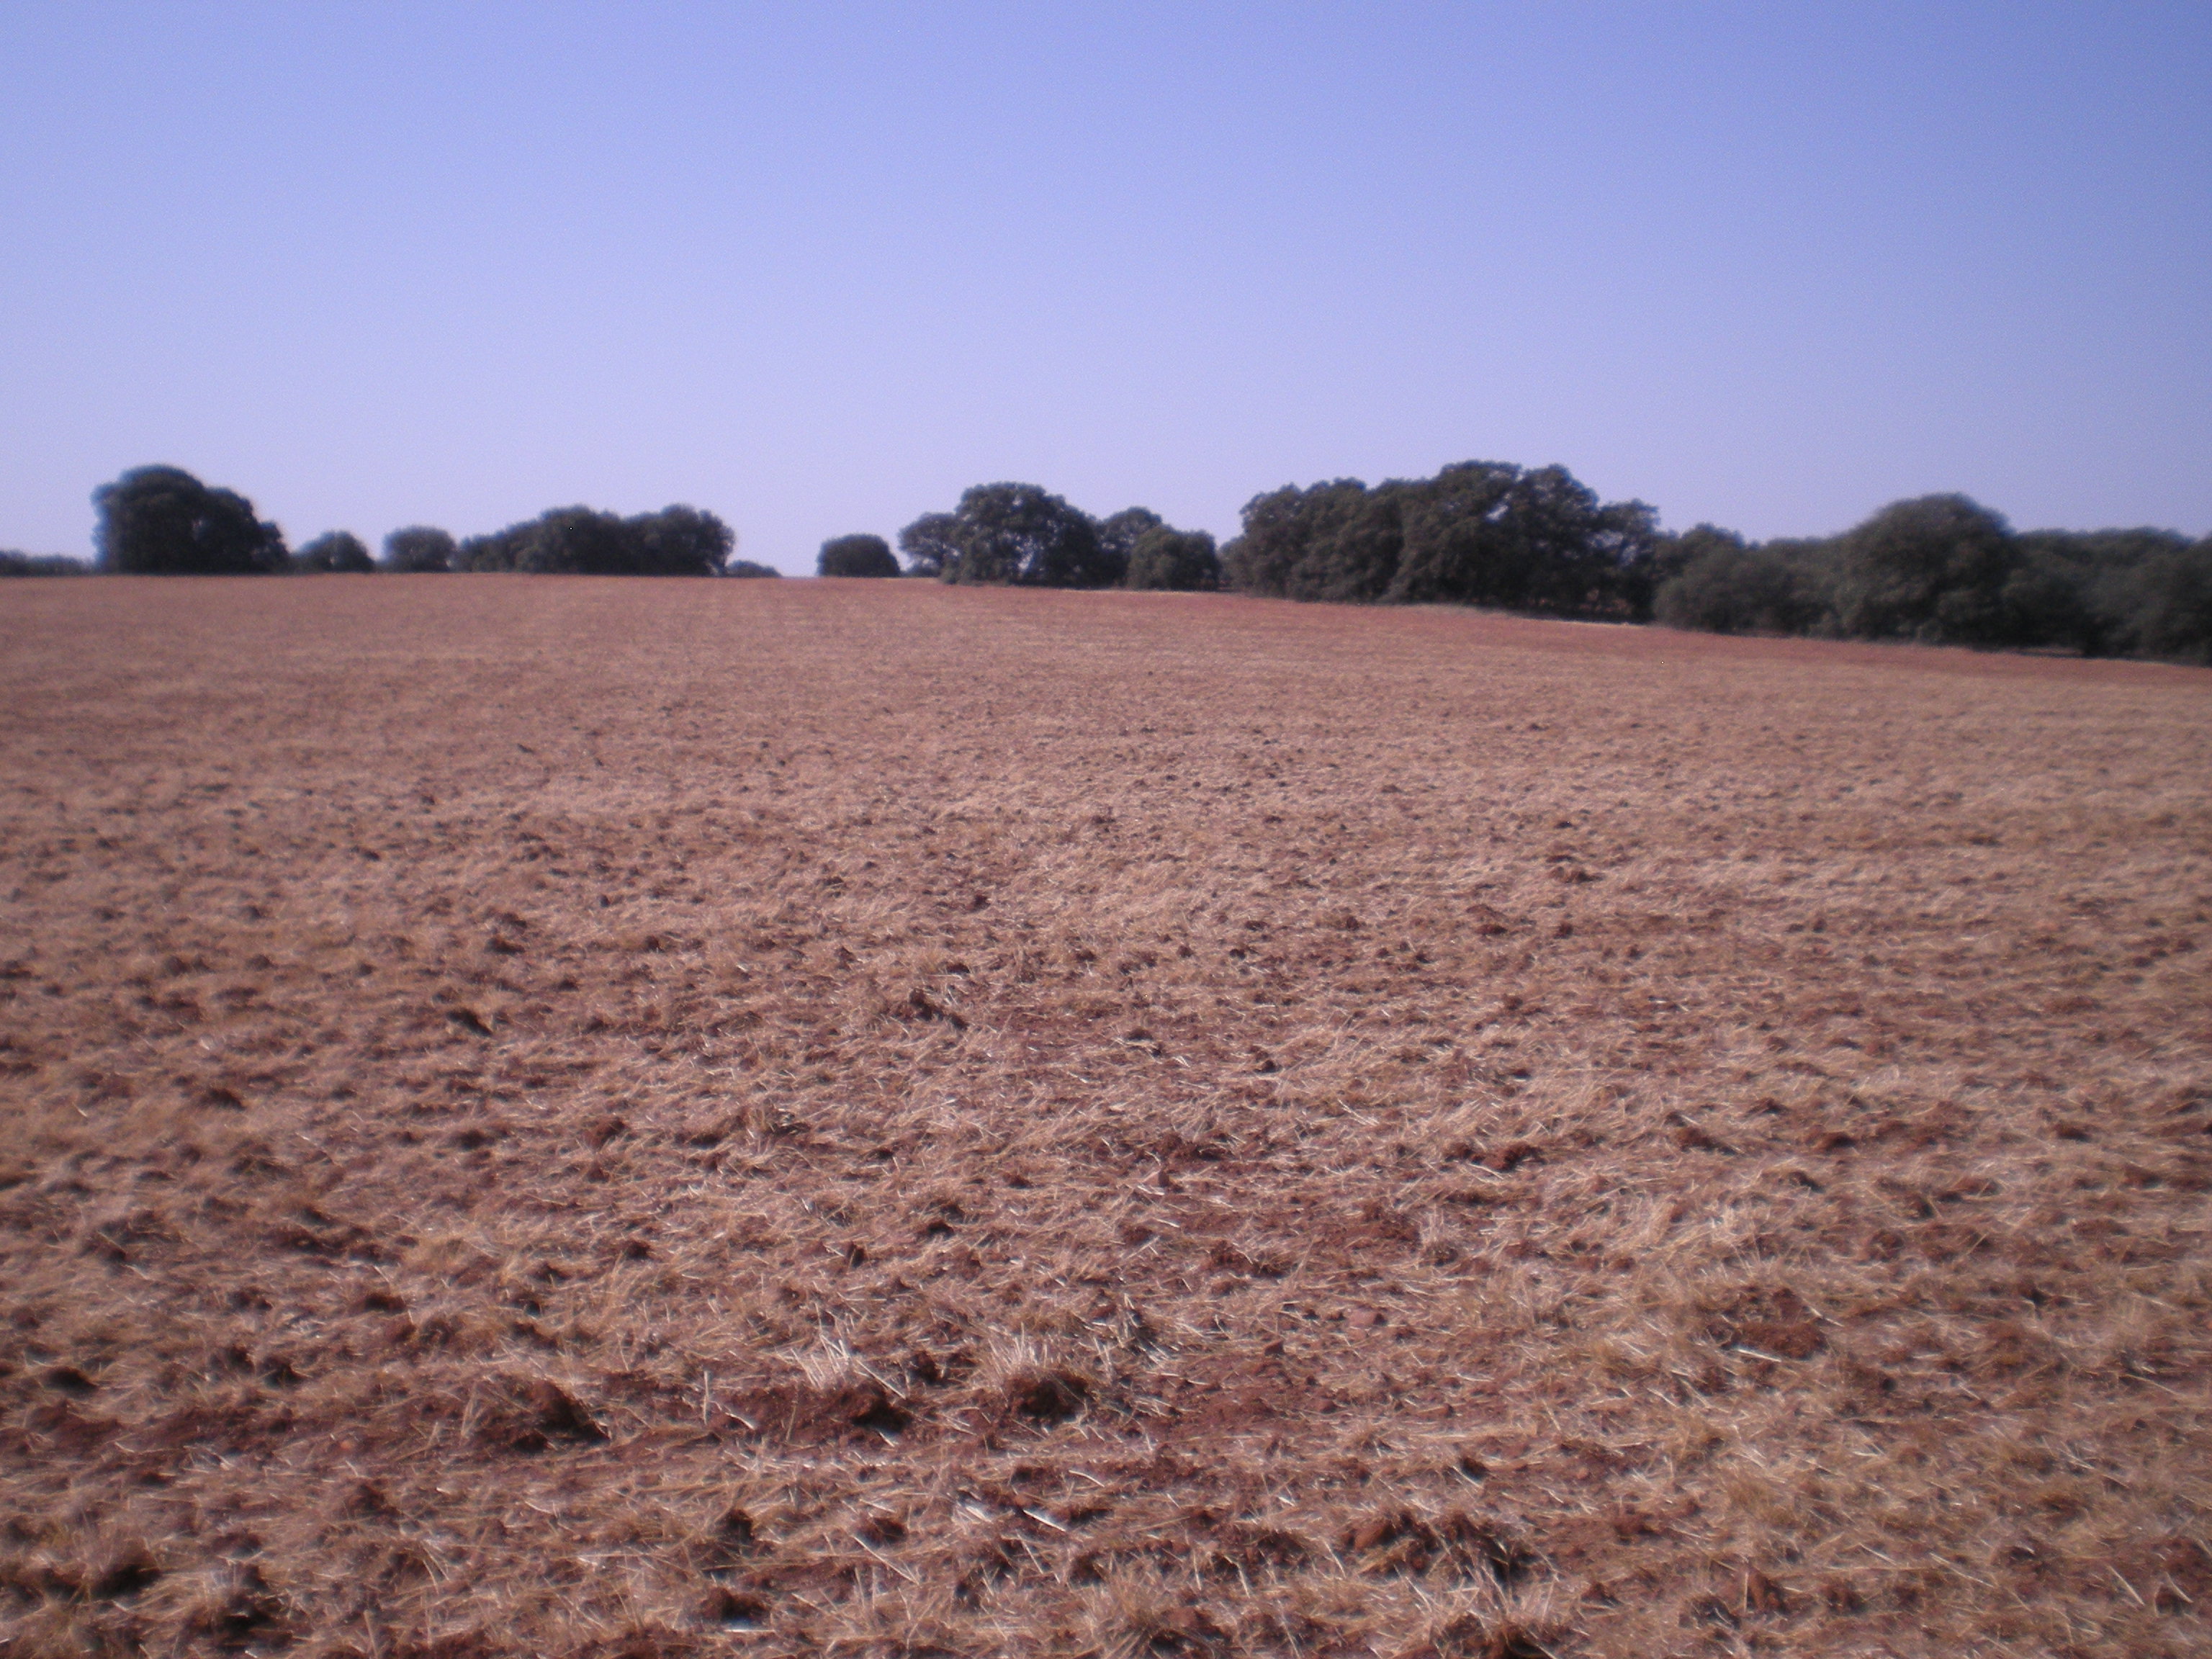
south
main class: Cropland
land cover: Barley
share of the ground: < 10 %
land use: Agriculture (excluding fallow land and kitchen gardens)
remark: Harvested field
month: July
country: ES
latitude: 39.4854
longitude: -3.1683
